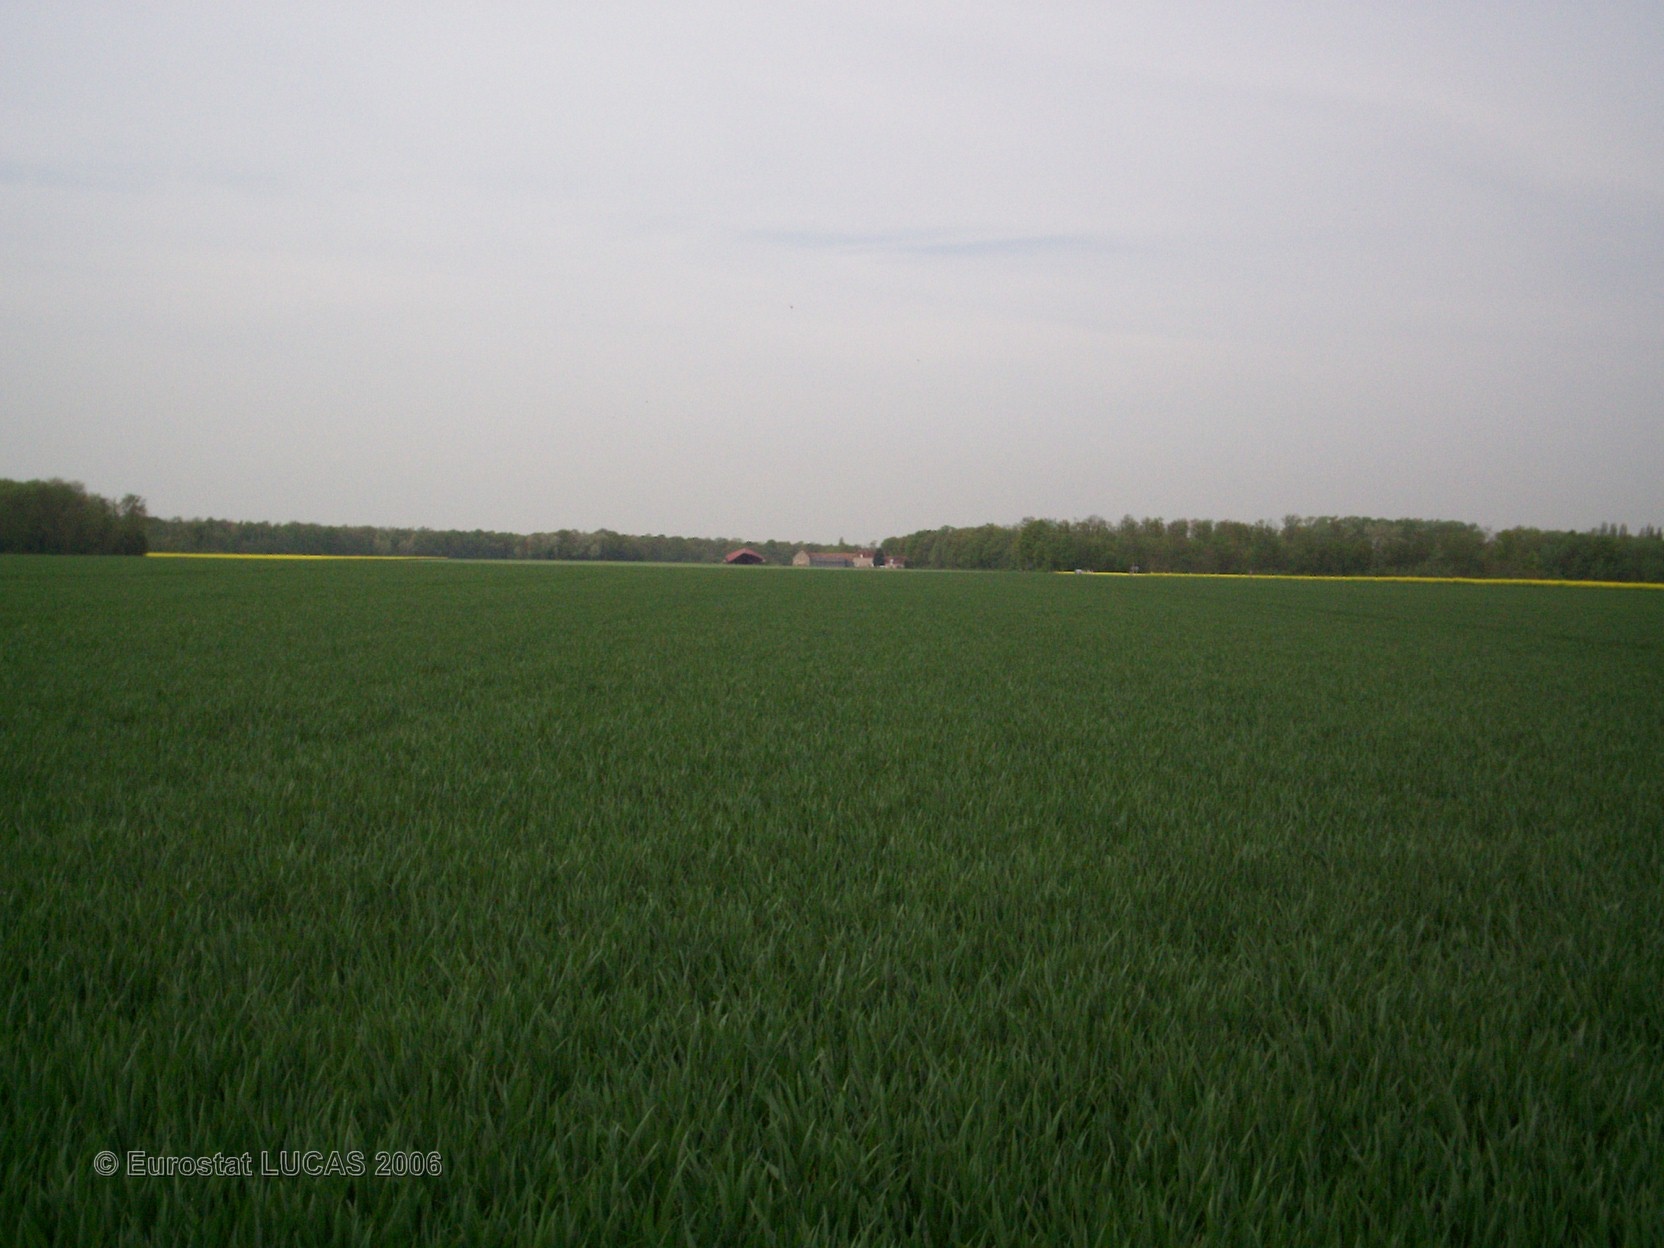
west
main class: Cropland
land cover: Common wheat
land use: Agriculture (excluding fallow land and kitchen gardens)
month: May
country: FR
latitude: 48.6801
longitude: 2.8877
